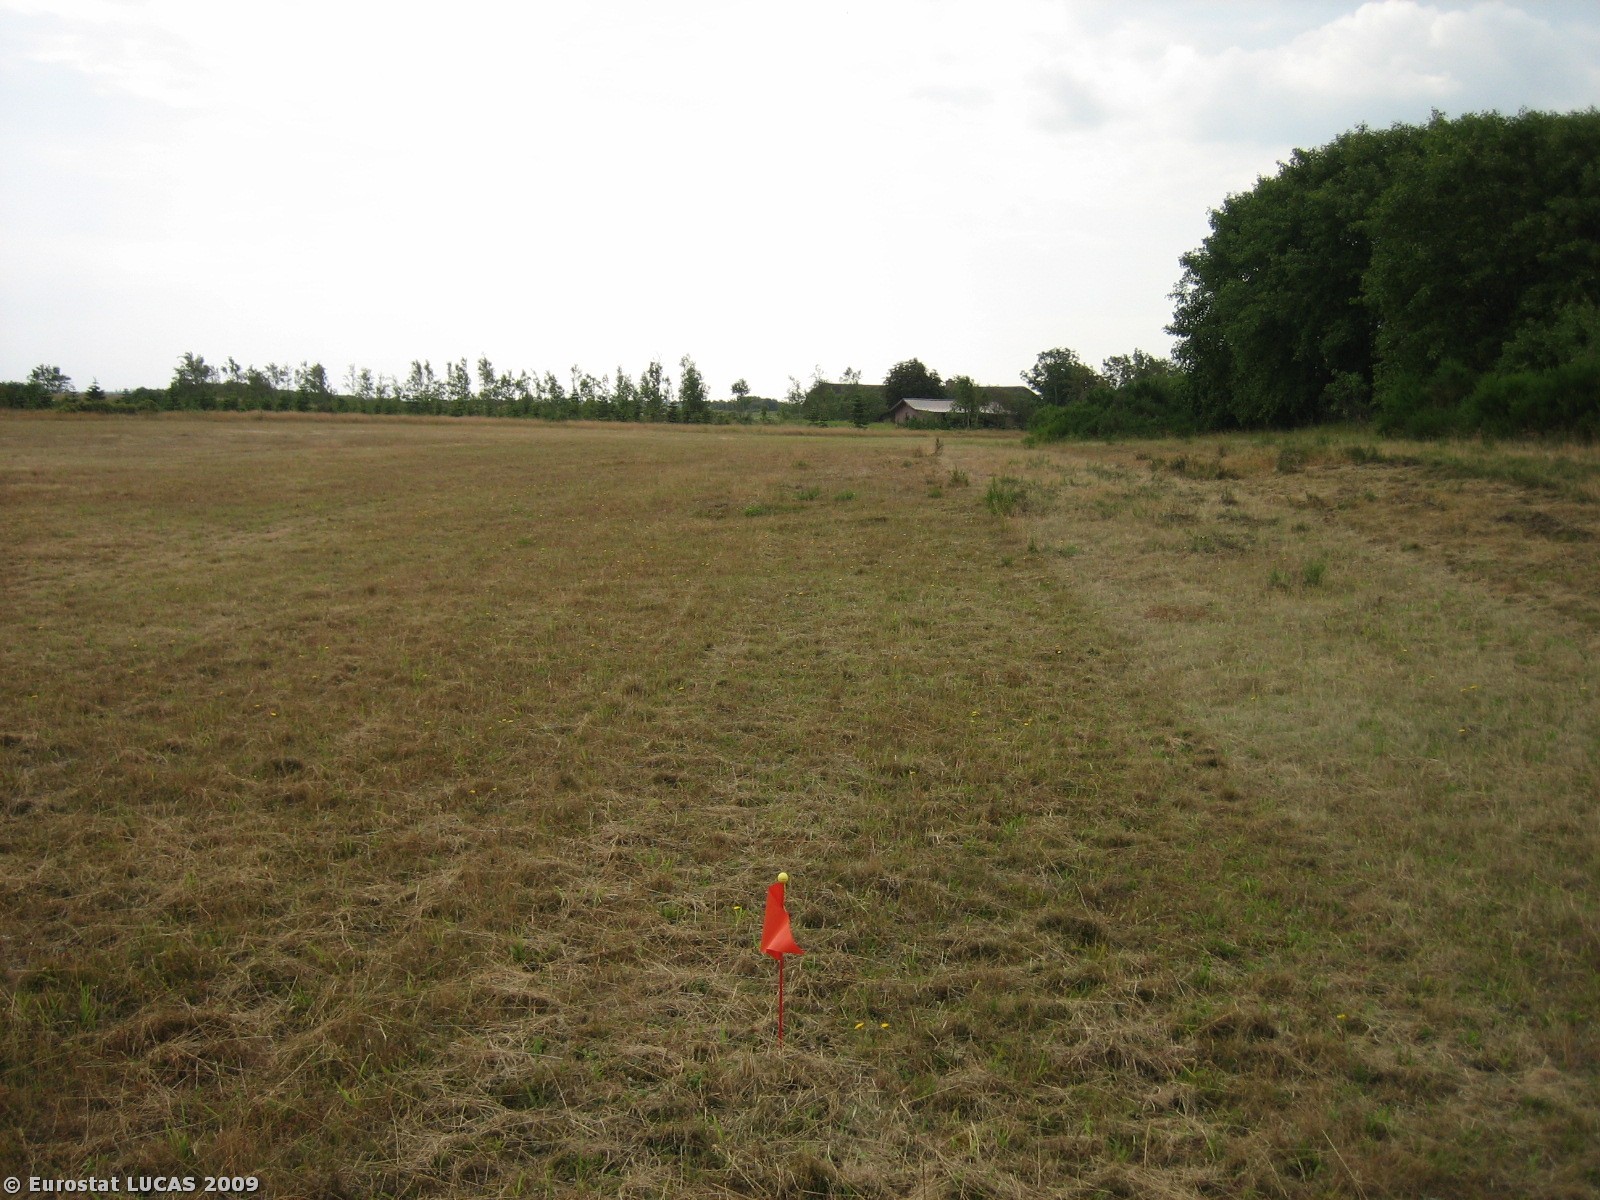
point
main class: Grassland
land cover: Grassland without tree/shrub cover
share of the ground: > 75 %
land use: Agriculture (excluding fallow land and kitchen gardens)
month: July
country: DK
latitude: 55.8724
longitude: 8.4194
